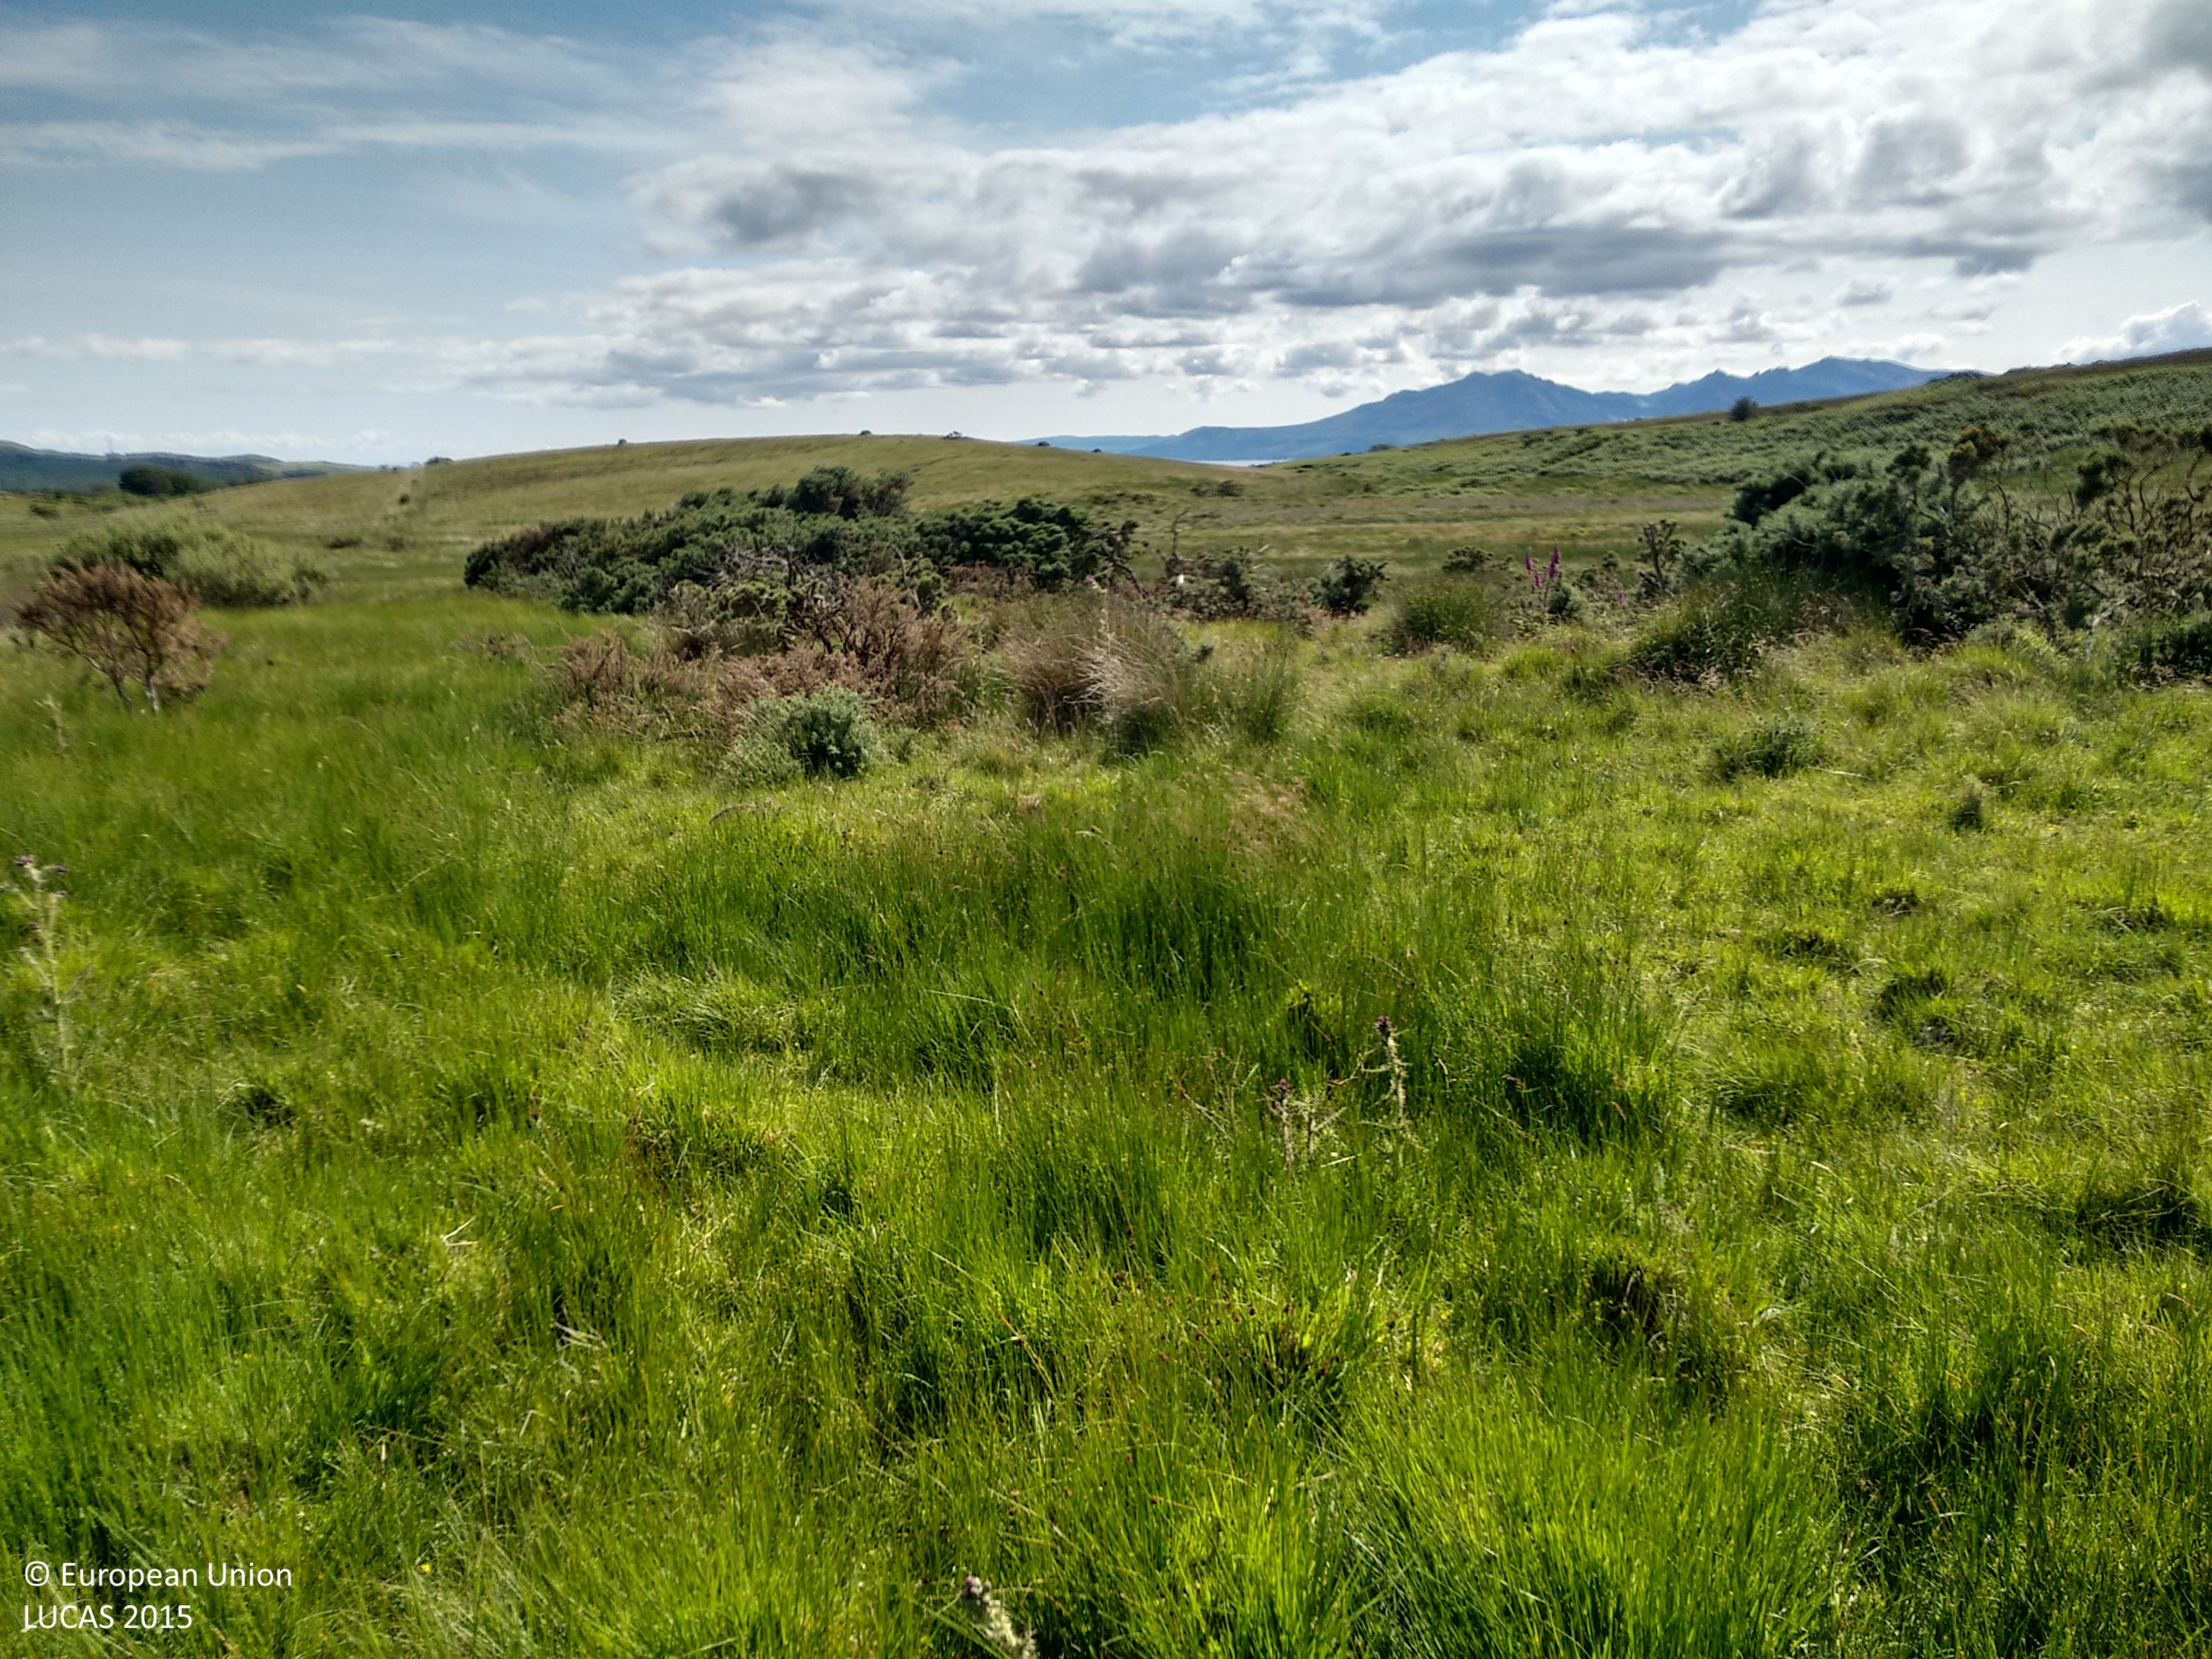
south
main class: Grassland
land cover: Grassland without tree/shrub cover
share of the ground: > 75 %
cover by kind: herbaceous plants 70 %, lichens and mosses 30 %
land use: Agriculture (excluding fallow land and kitchen gardens)
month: July
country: GB
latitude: 55.7871
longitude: -5.0544
